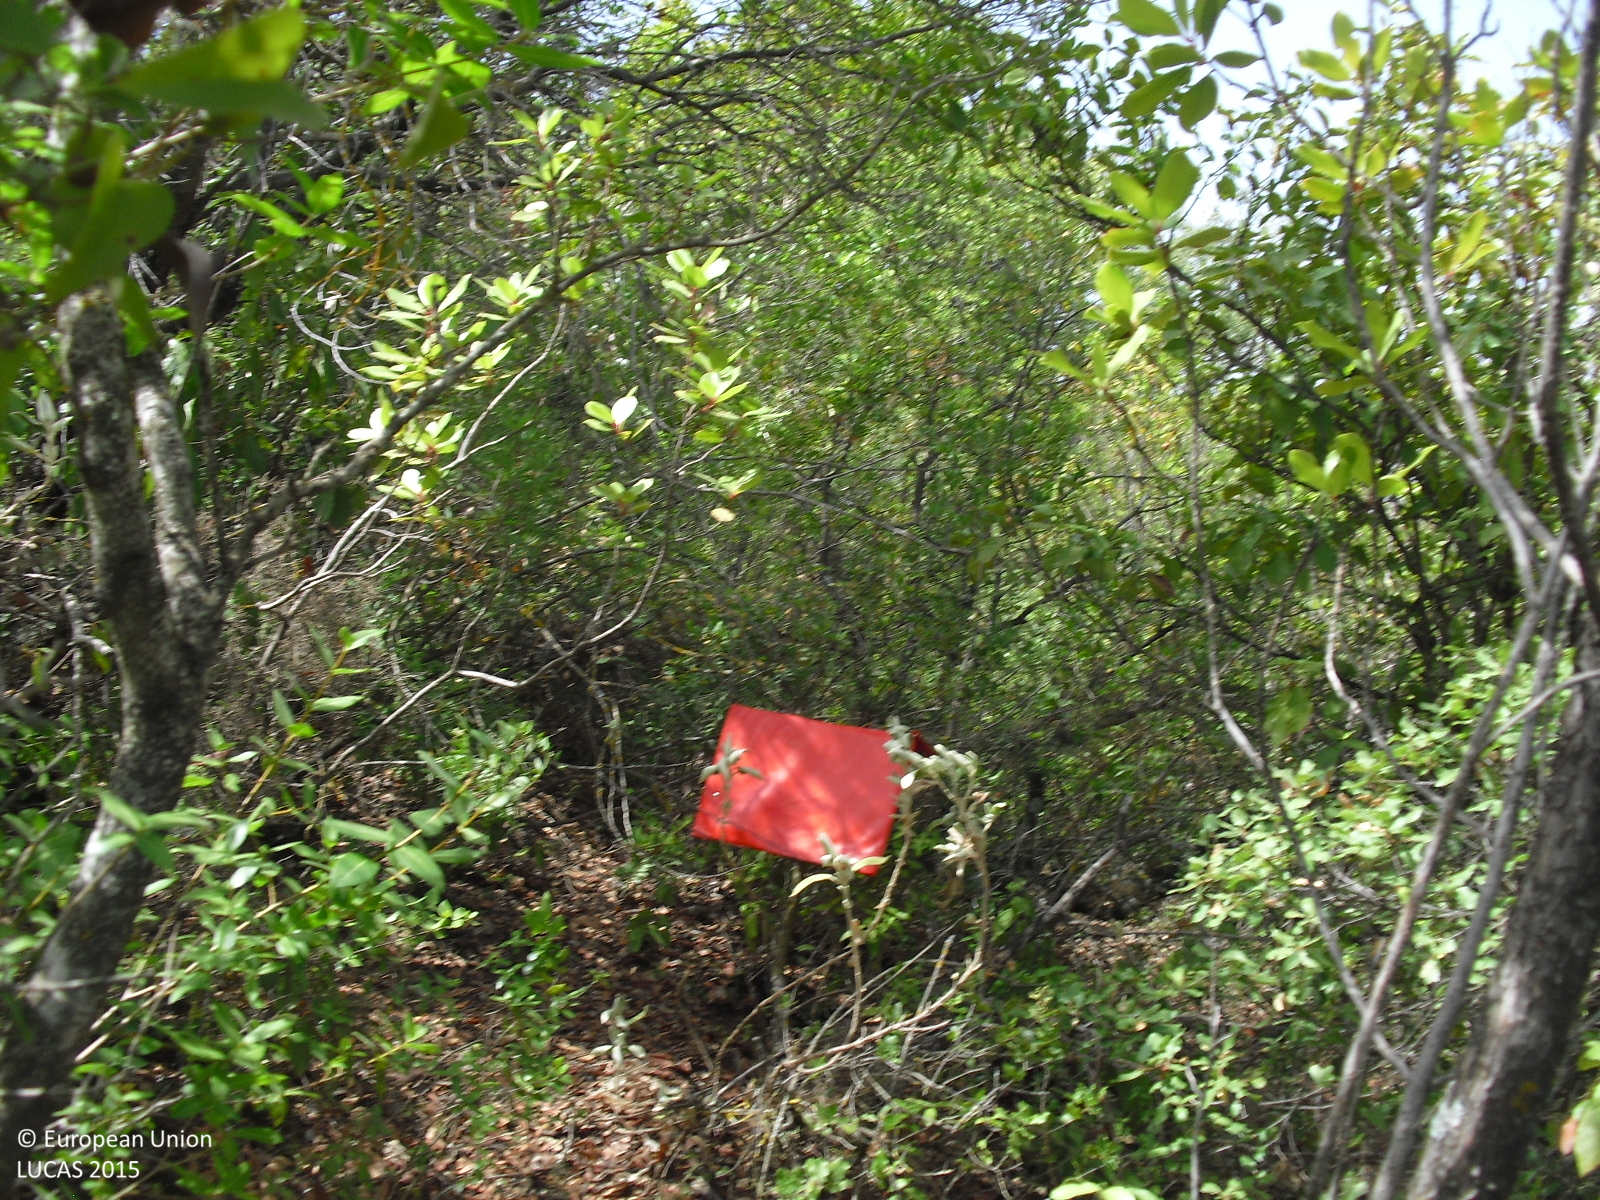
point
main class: Woodland
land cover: Broadleaved woodland
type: broadleaved evergreen forest
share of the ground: 25 - 50 %
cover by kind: shrubs 65 %, broadleaved forest trees 35 %
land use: Semi-natural and natural areas not in use
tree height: < 5 m
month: August
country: ES
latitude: 37.3697
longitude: -4.3524
